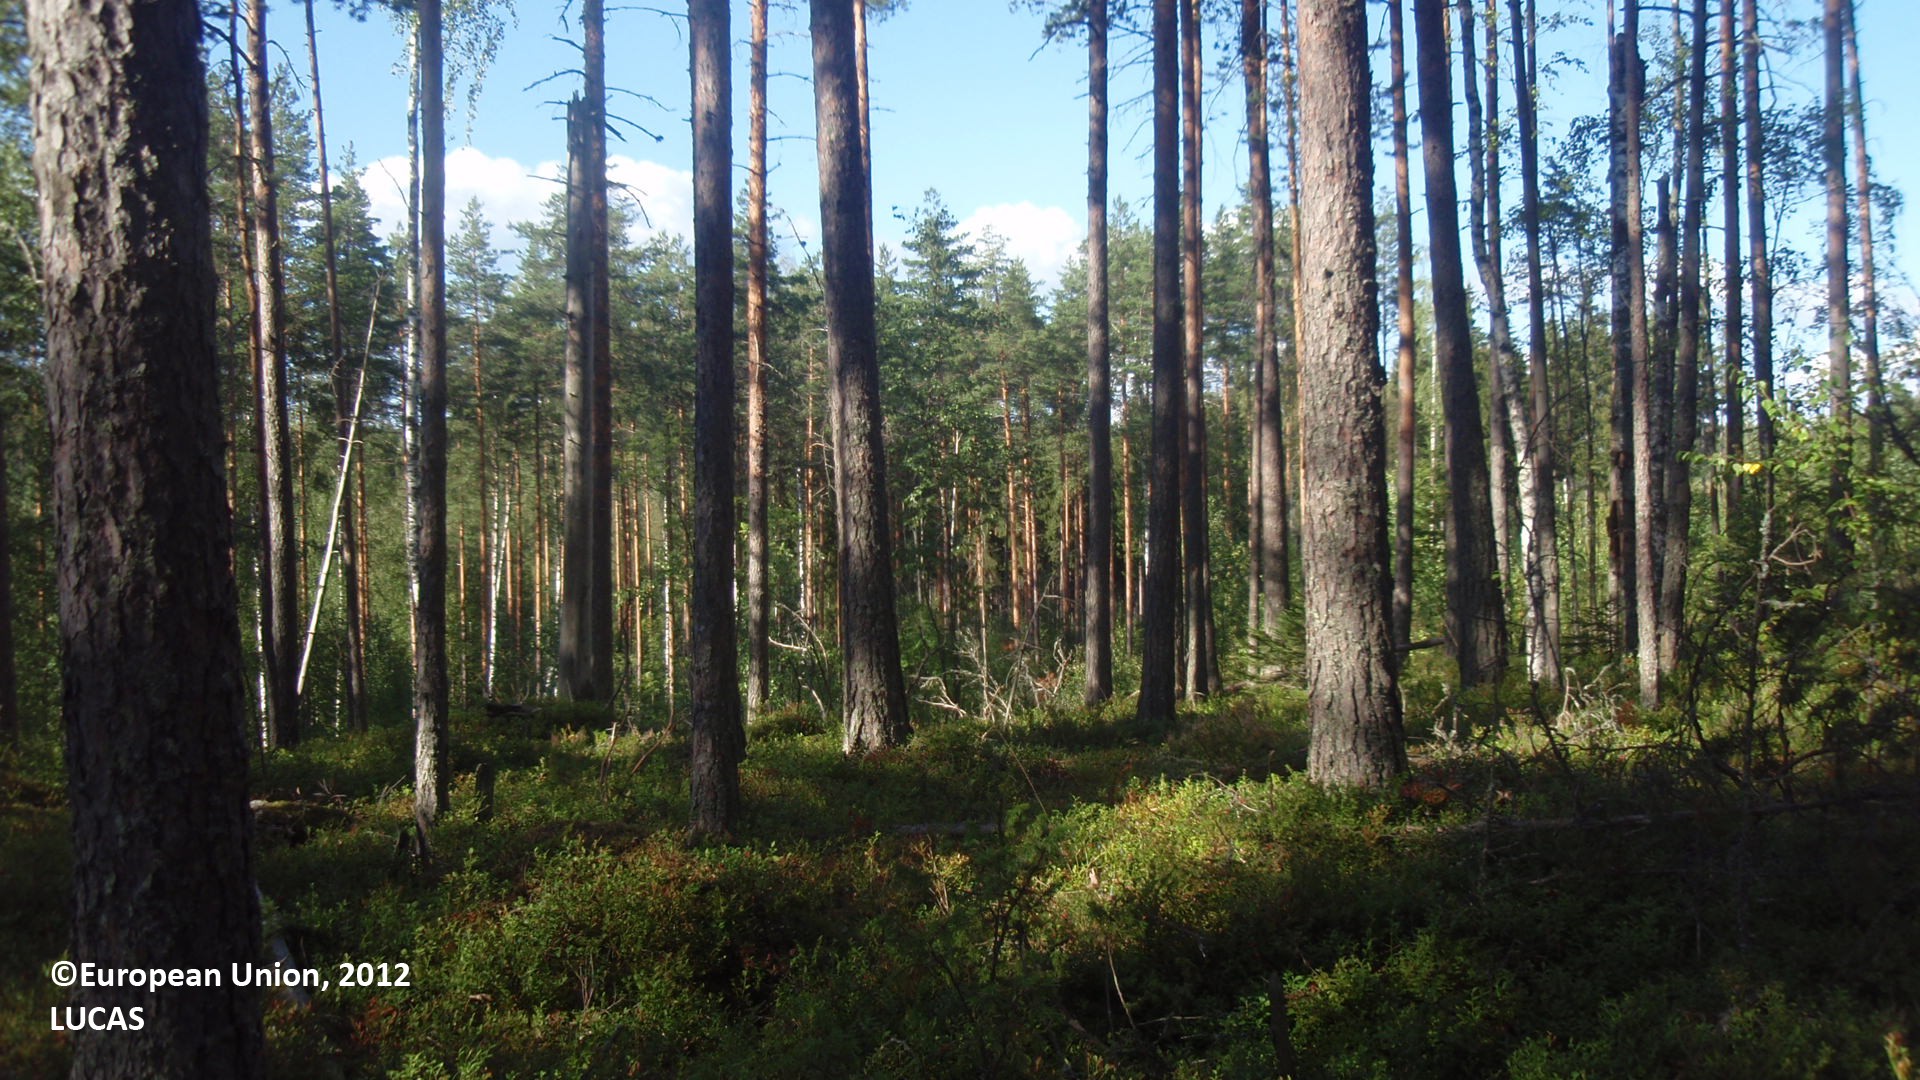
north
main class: Woodland
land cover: Pine dominated coniferous woodland
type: boreal forest
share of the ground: 50 - 75 %
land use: Forestry
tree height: > 5 m
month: August
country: FI
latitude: 61.5578
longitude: 27.7846
